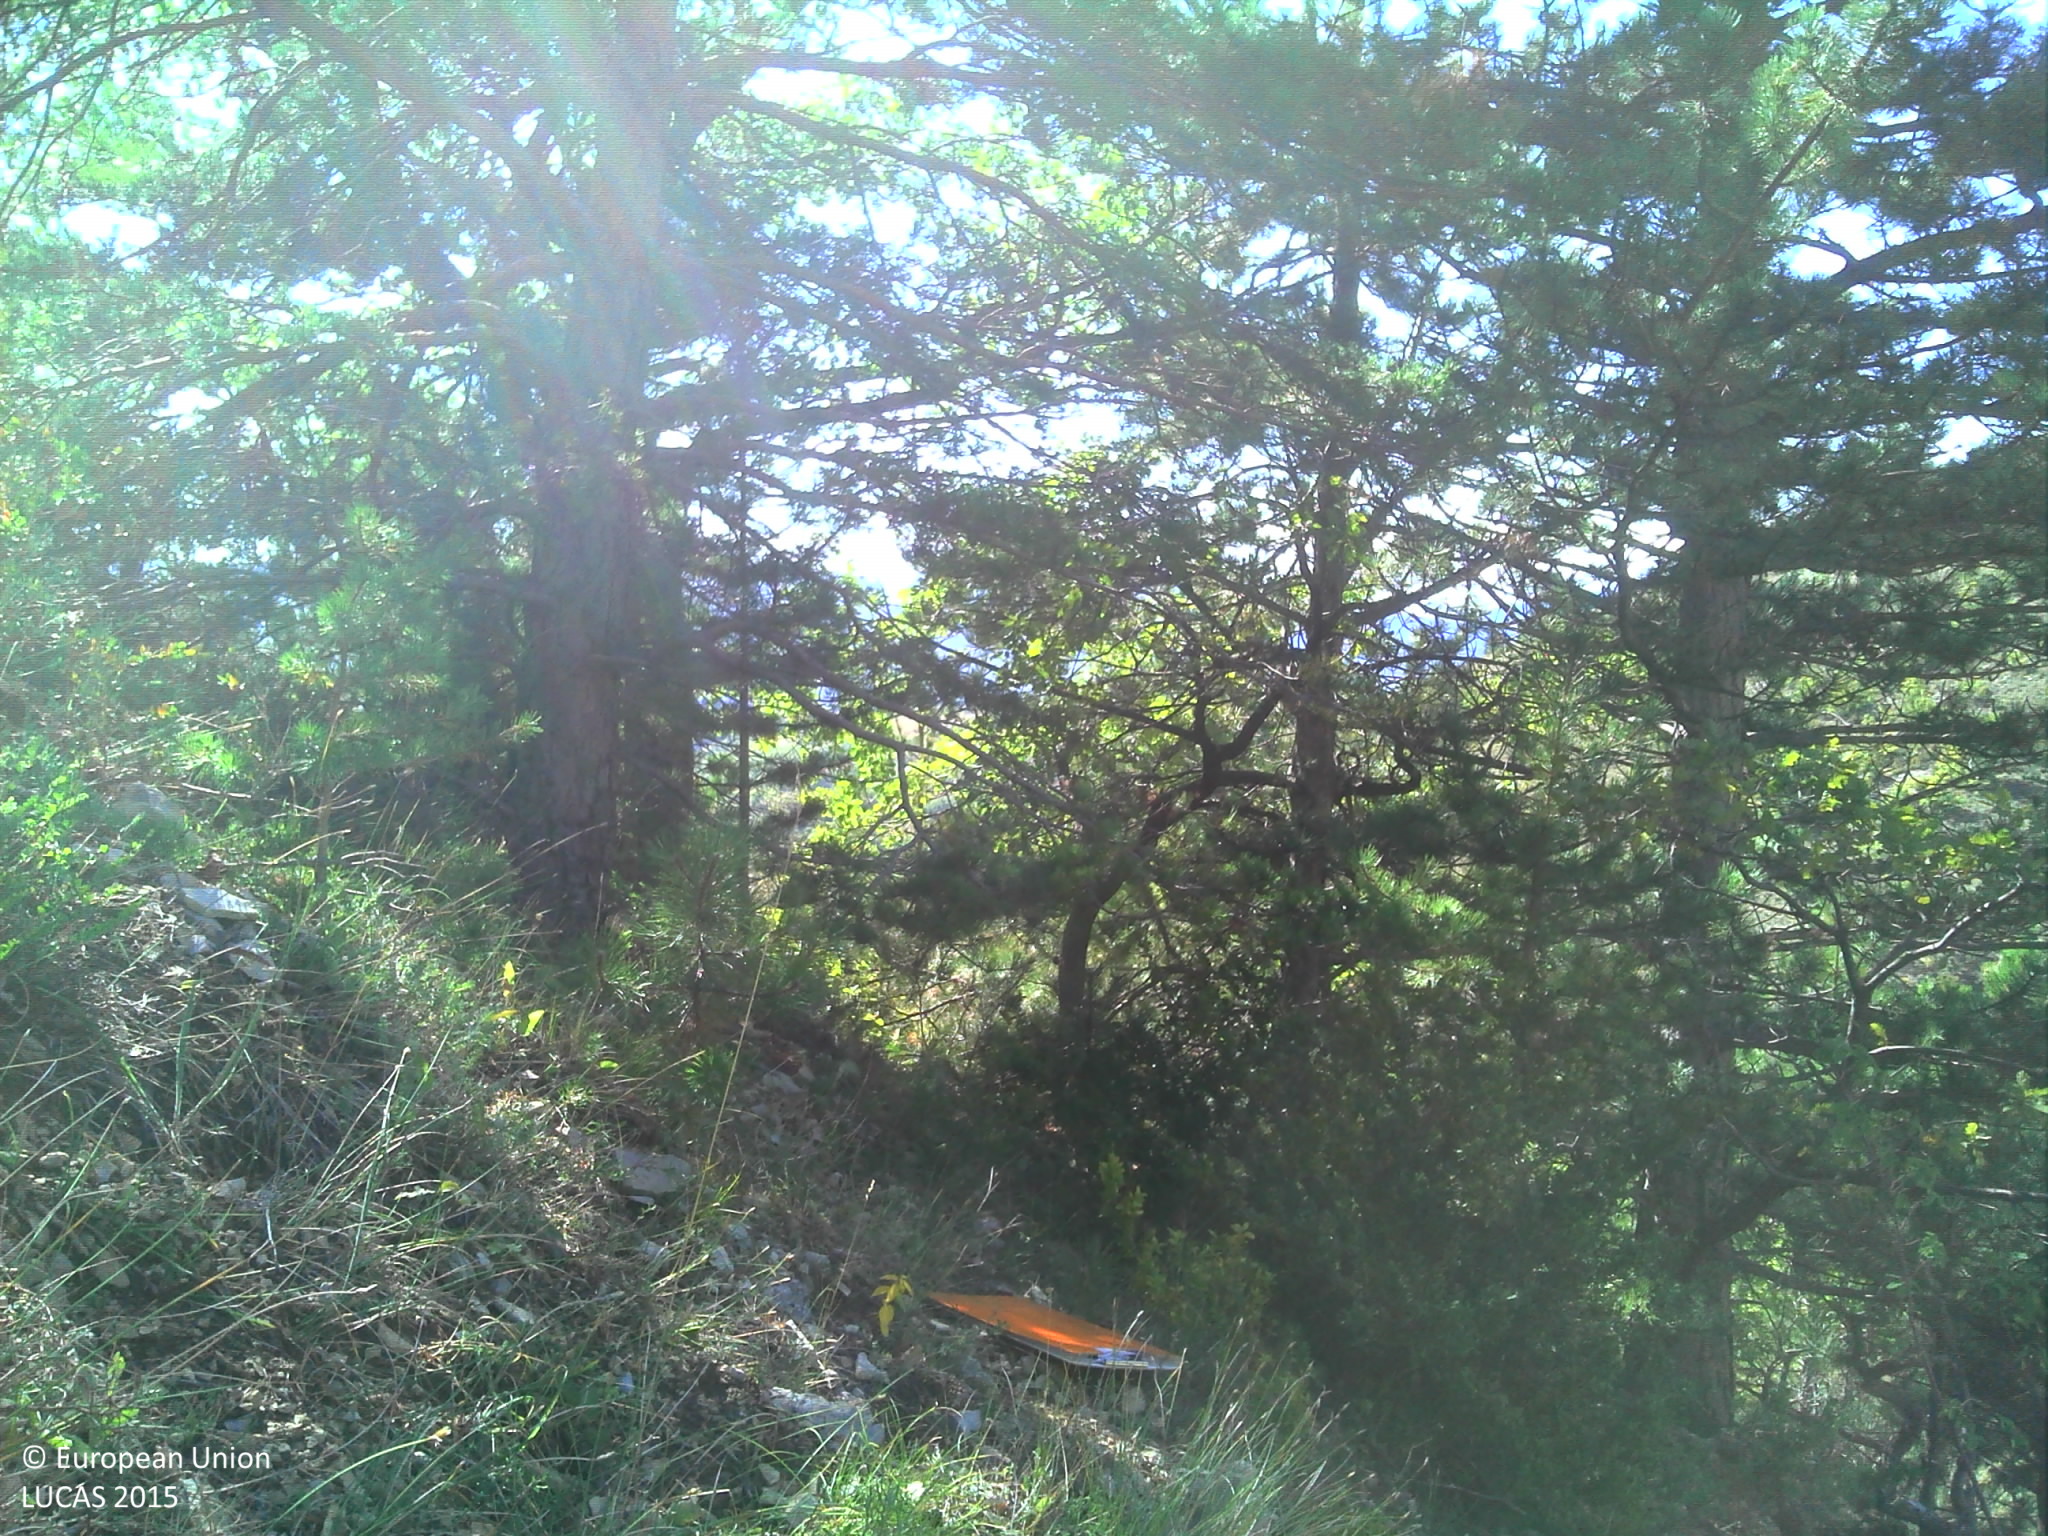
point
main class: Woodland
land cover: Pine dominated coniferous woodland
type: coniferous forest of the mediterranean region
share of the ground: > 75 %
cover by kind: coniferous forest trees 95 %, broadleaved forest trees 5 %
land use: Semi-natural and natural areas not in use
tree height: > 5 m
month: September
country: FR
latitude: 44.3717
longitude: 5.3264
